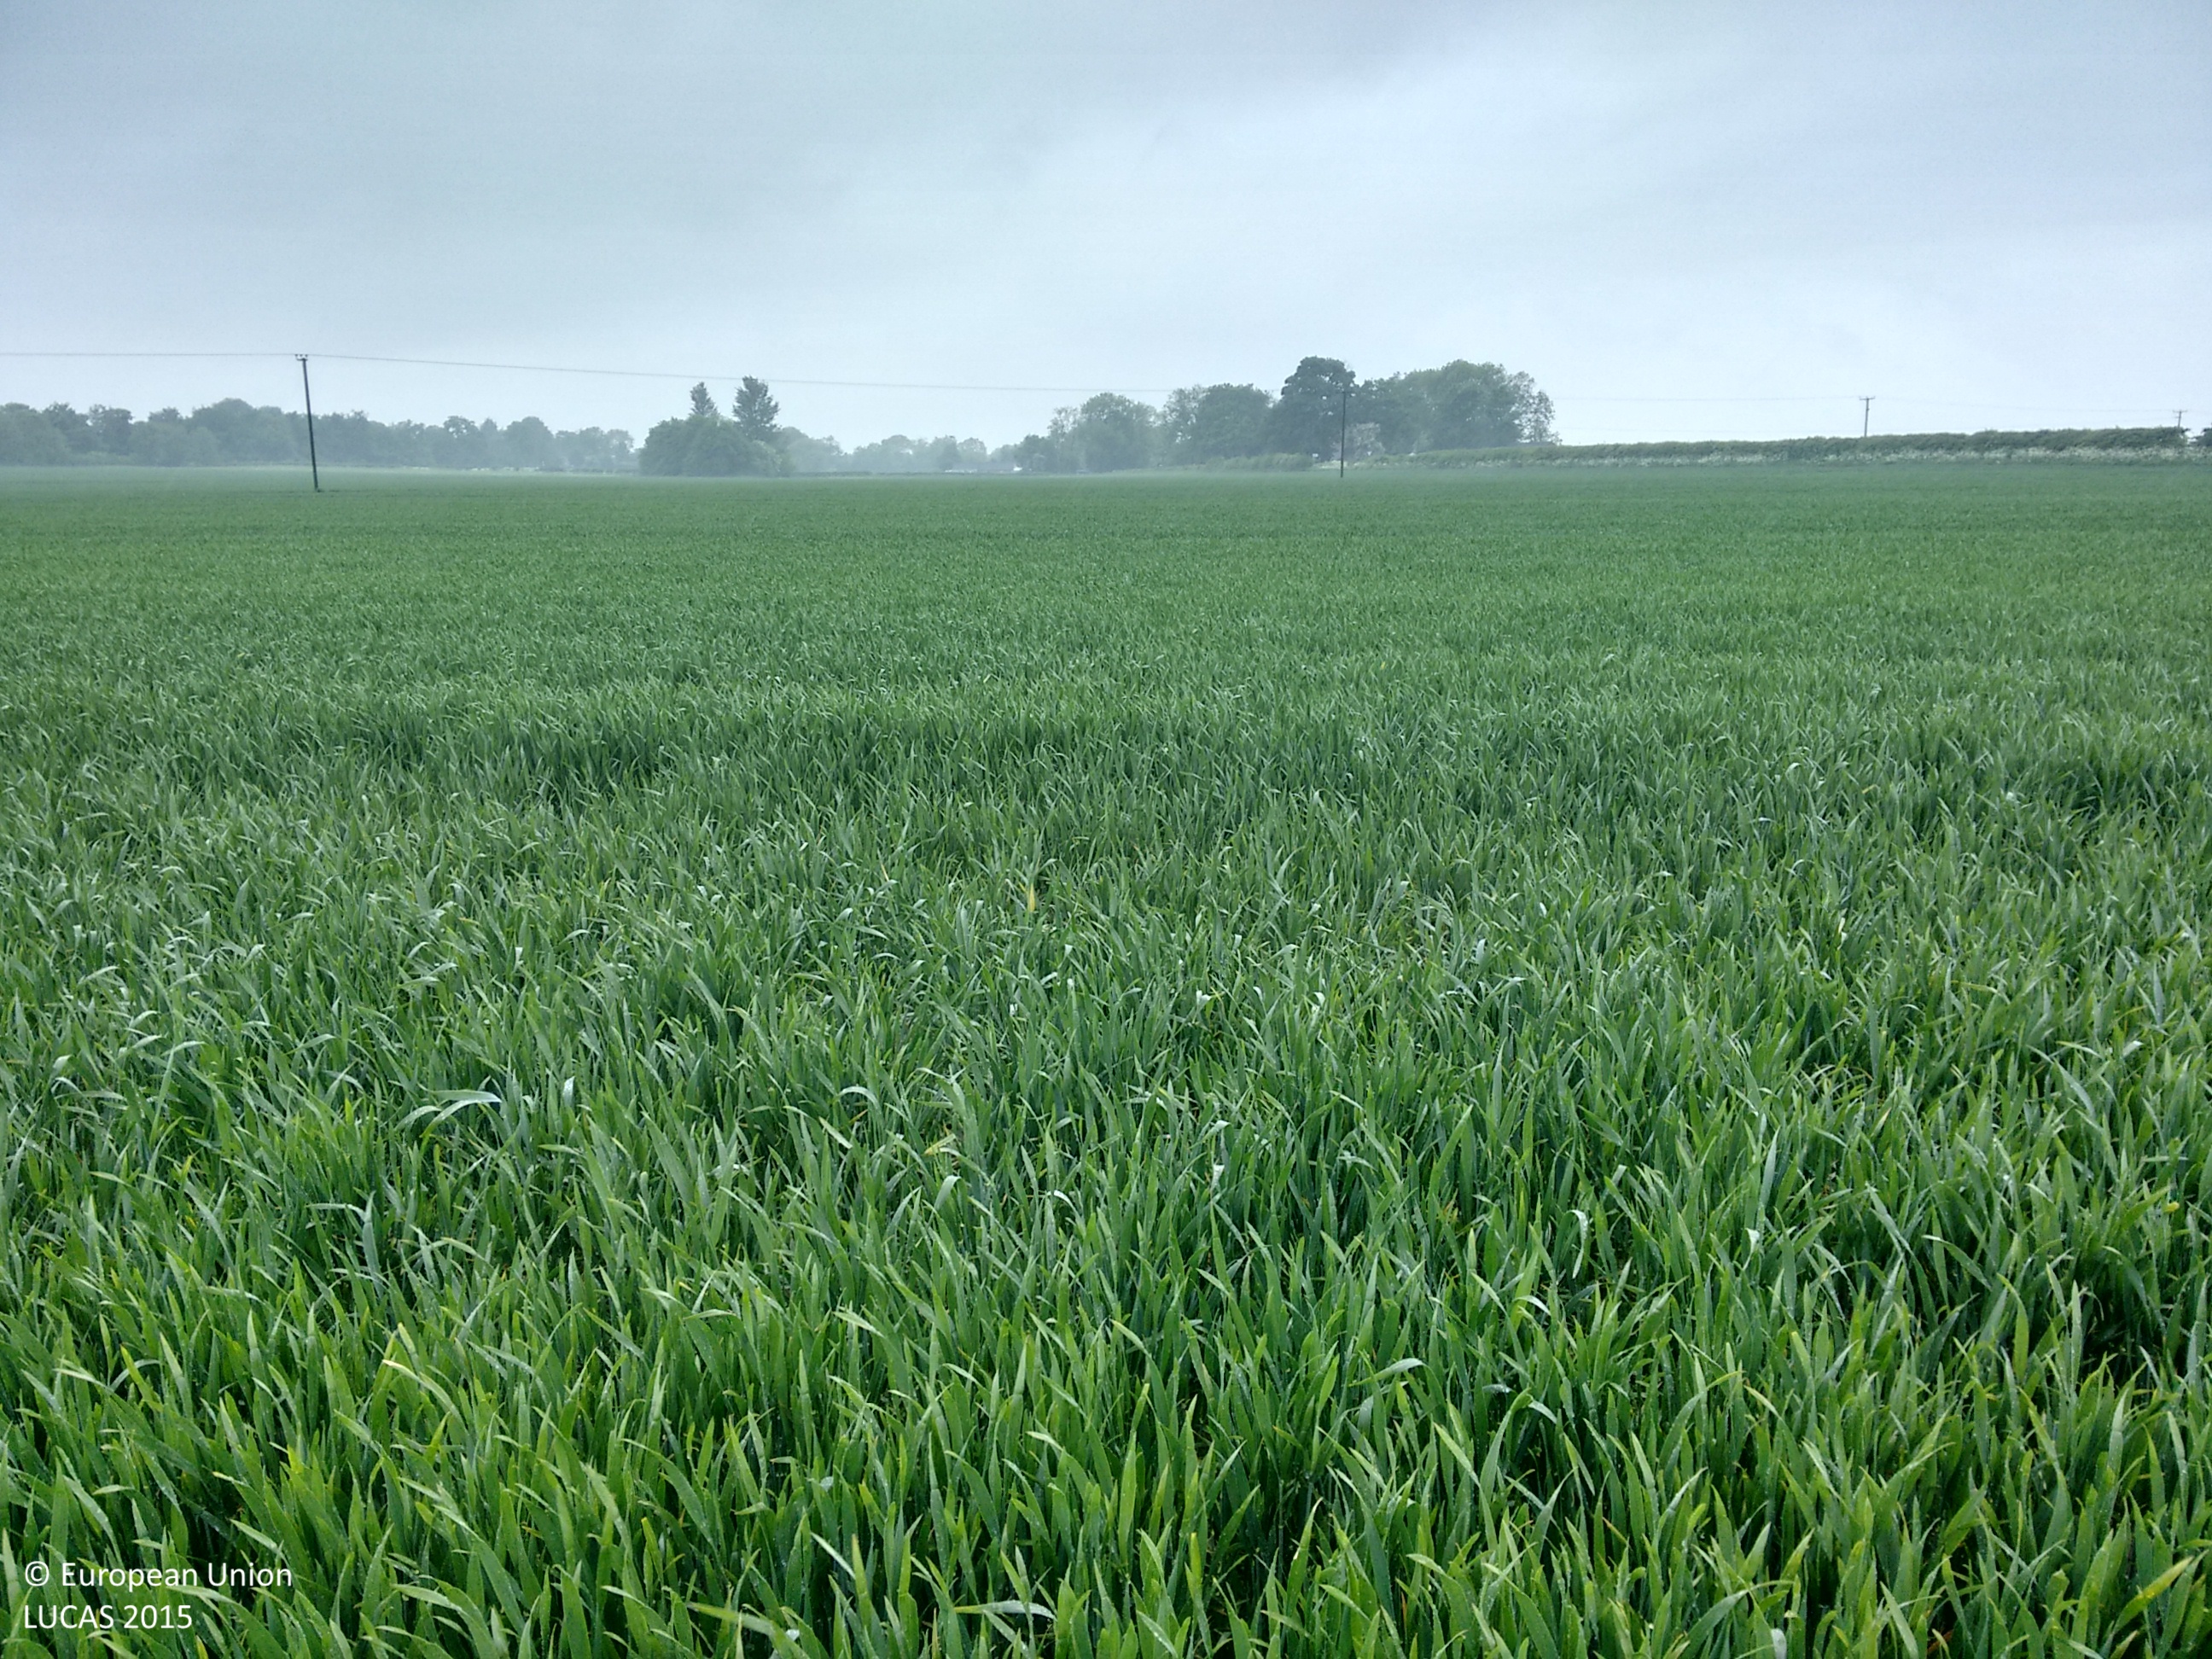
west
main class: Cropland
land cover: Common wheat
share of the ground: > 75 %
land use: Agriculture (excluding fallow land and kitchen gardens)
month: May
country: GB
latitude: 53.3225
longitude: -0.3191
